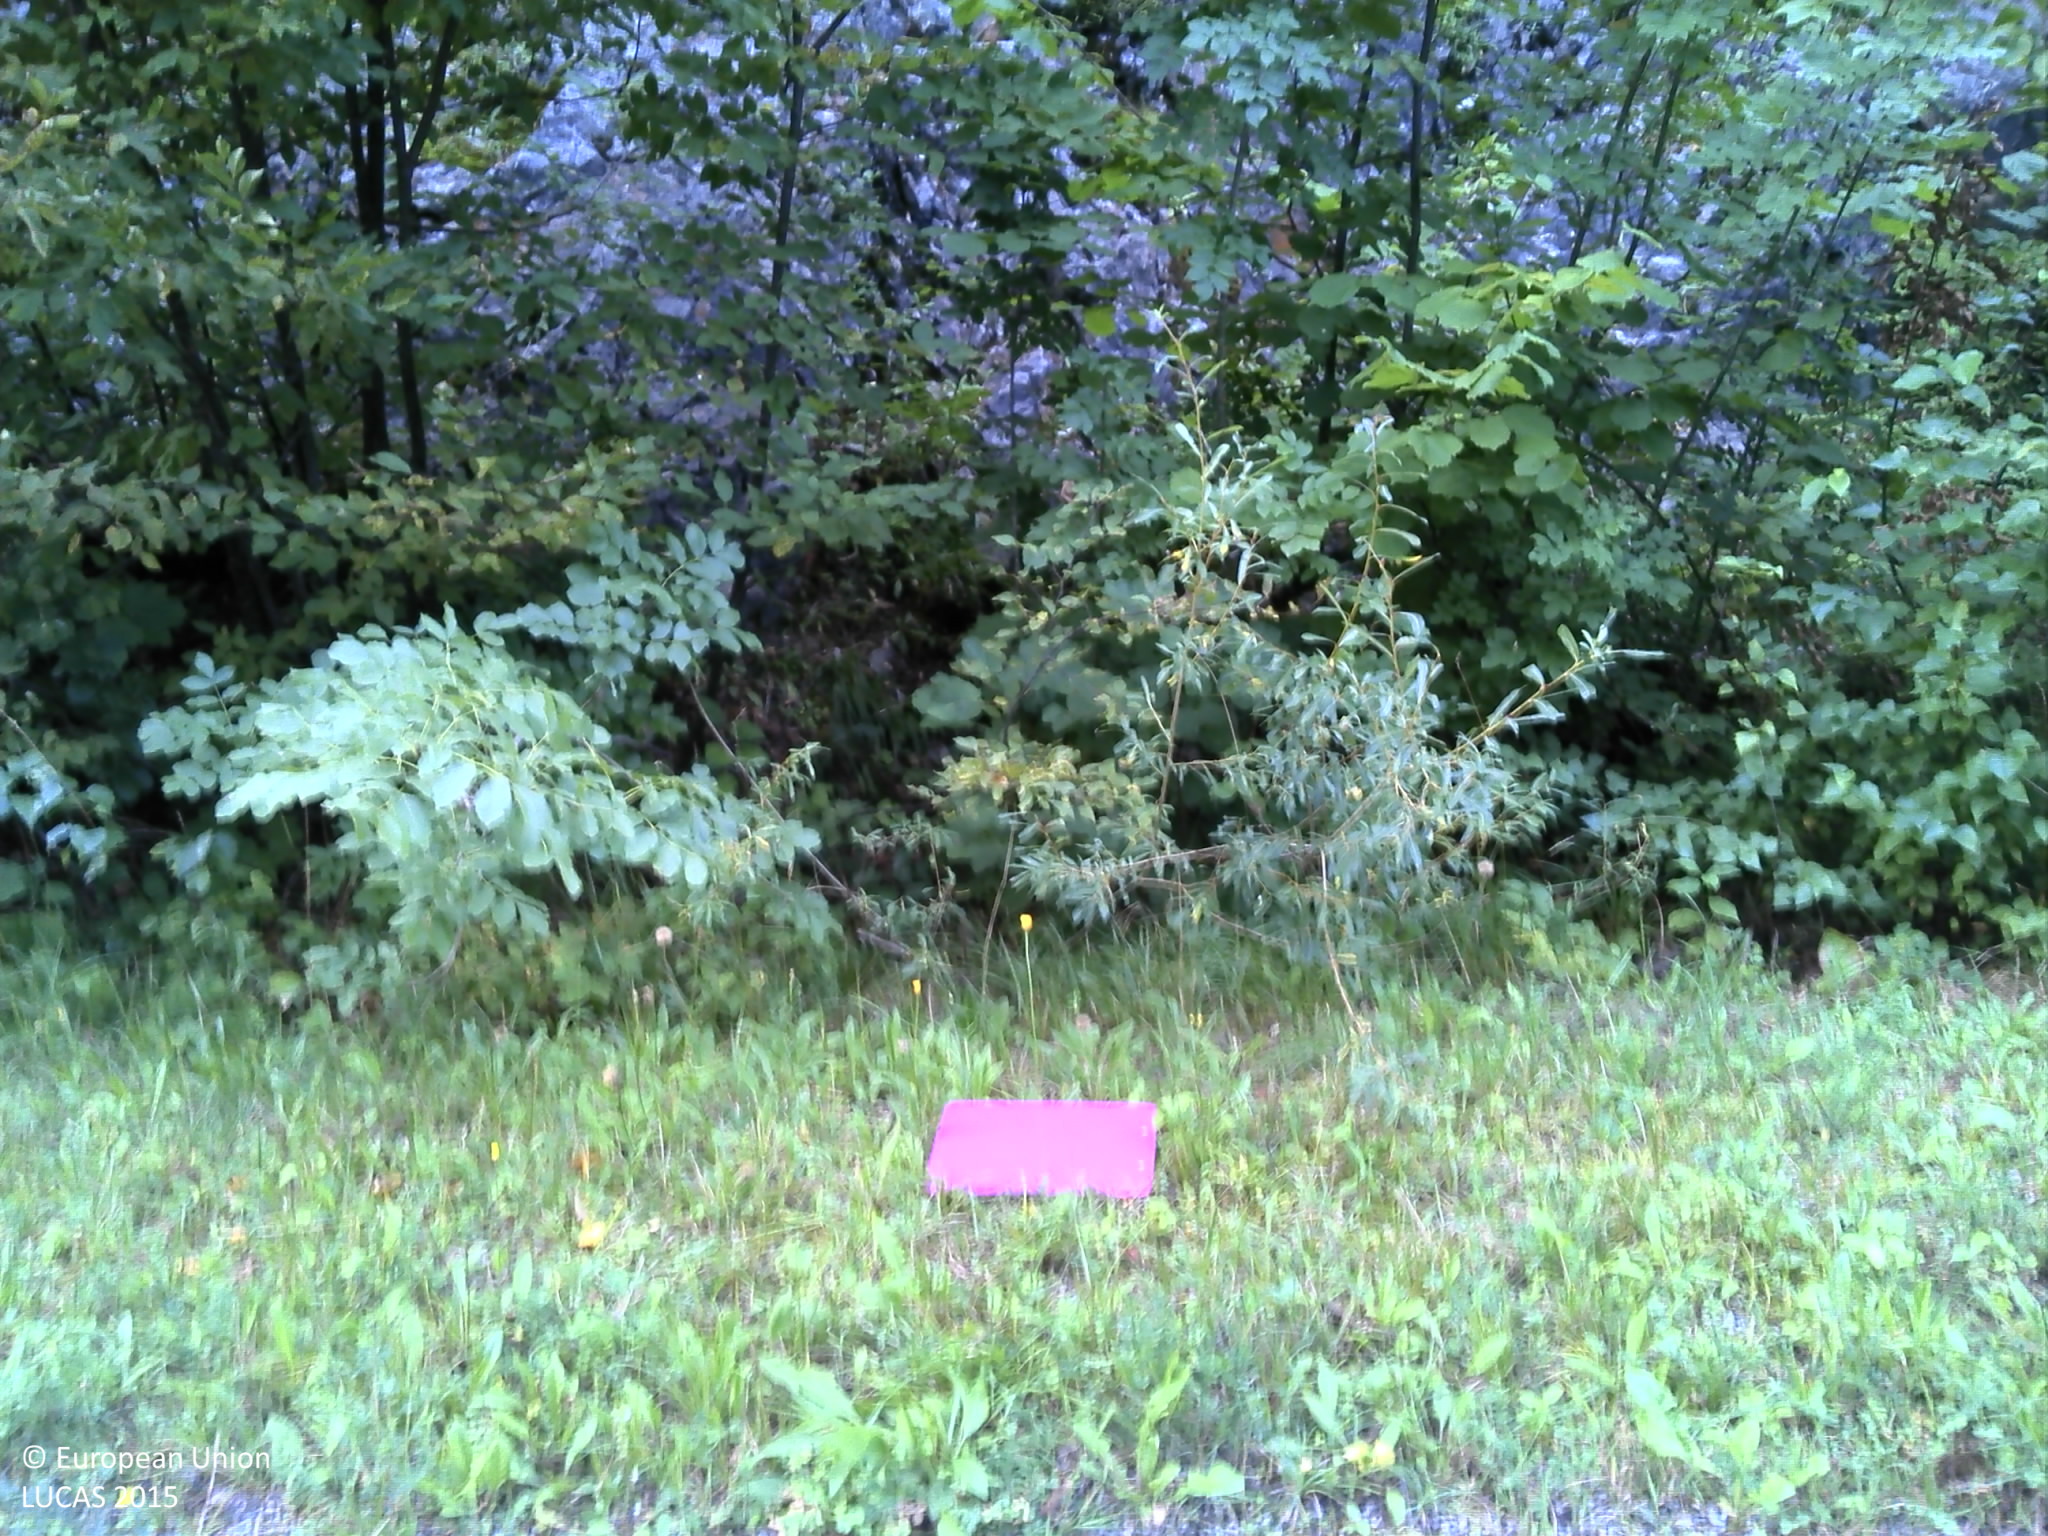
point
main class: Grassland
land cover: Spontaneously vegetated surfaces
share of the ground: > 75 %
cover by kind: herbaceous plants 100 %
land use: Fallow land
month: September
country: HR
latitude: 45.2688
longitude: 15.1827
